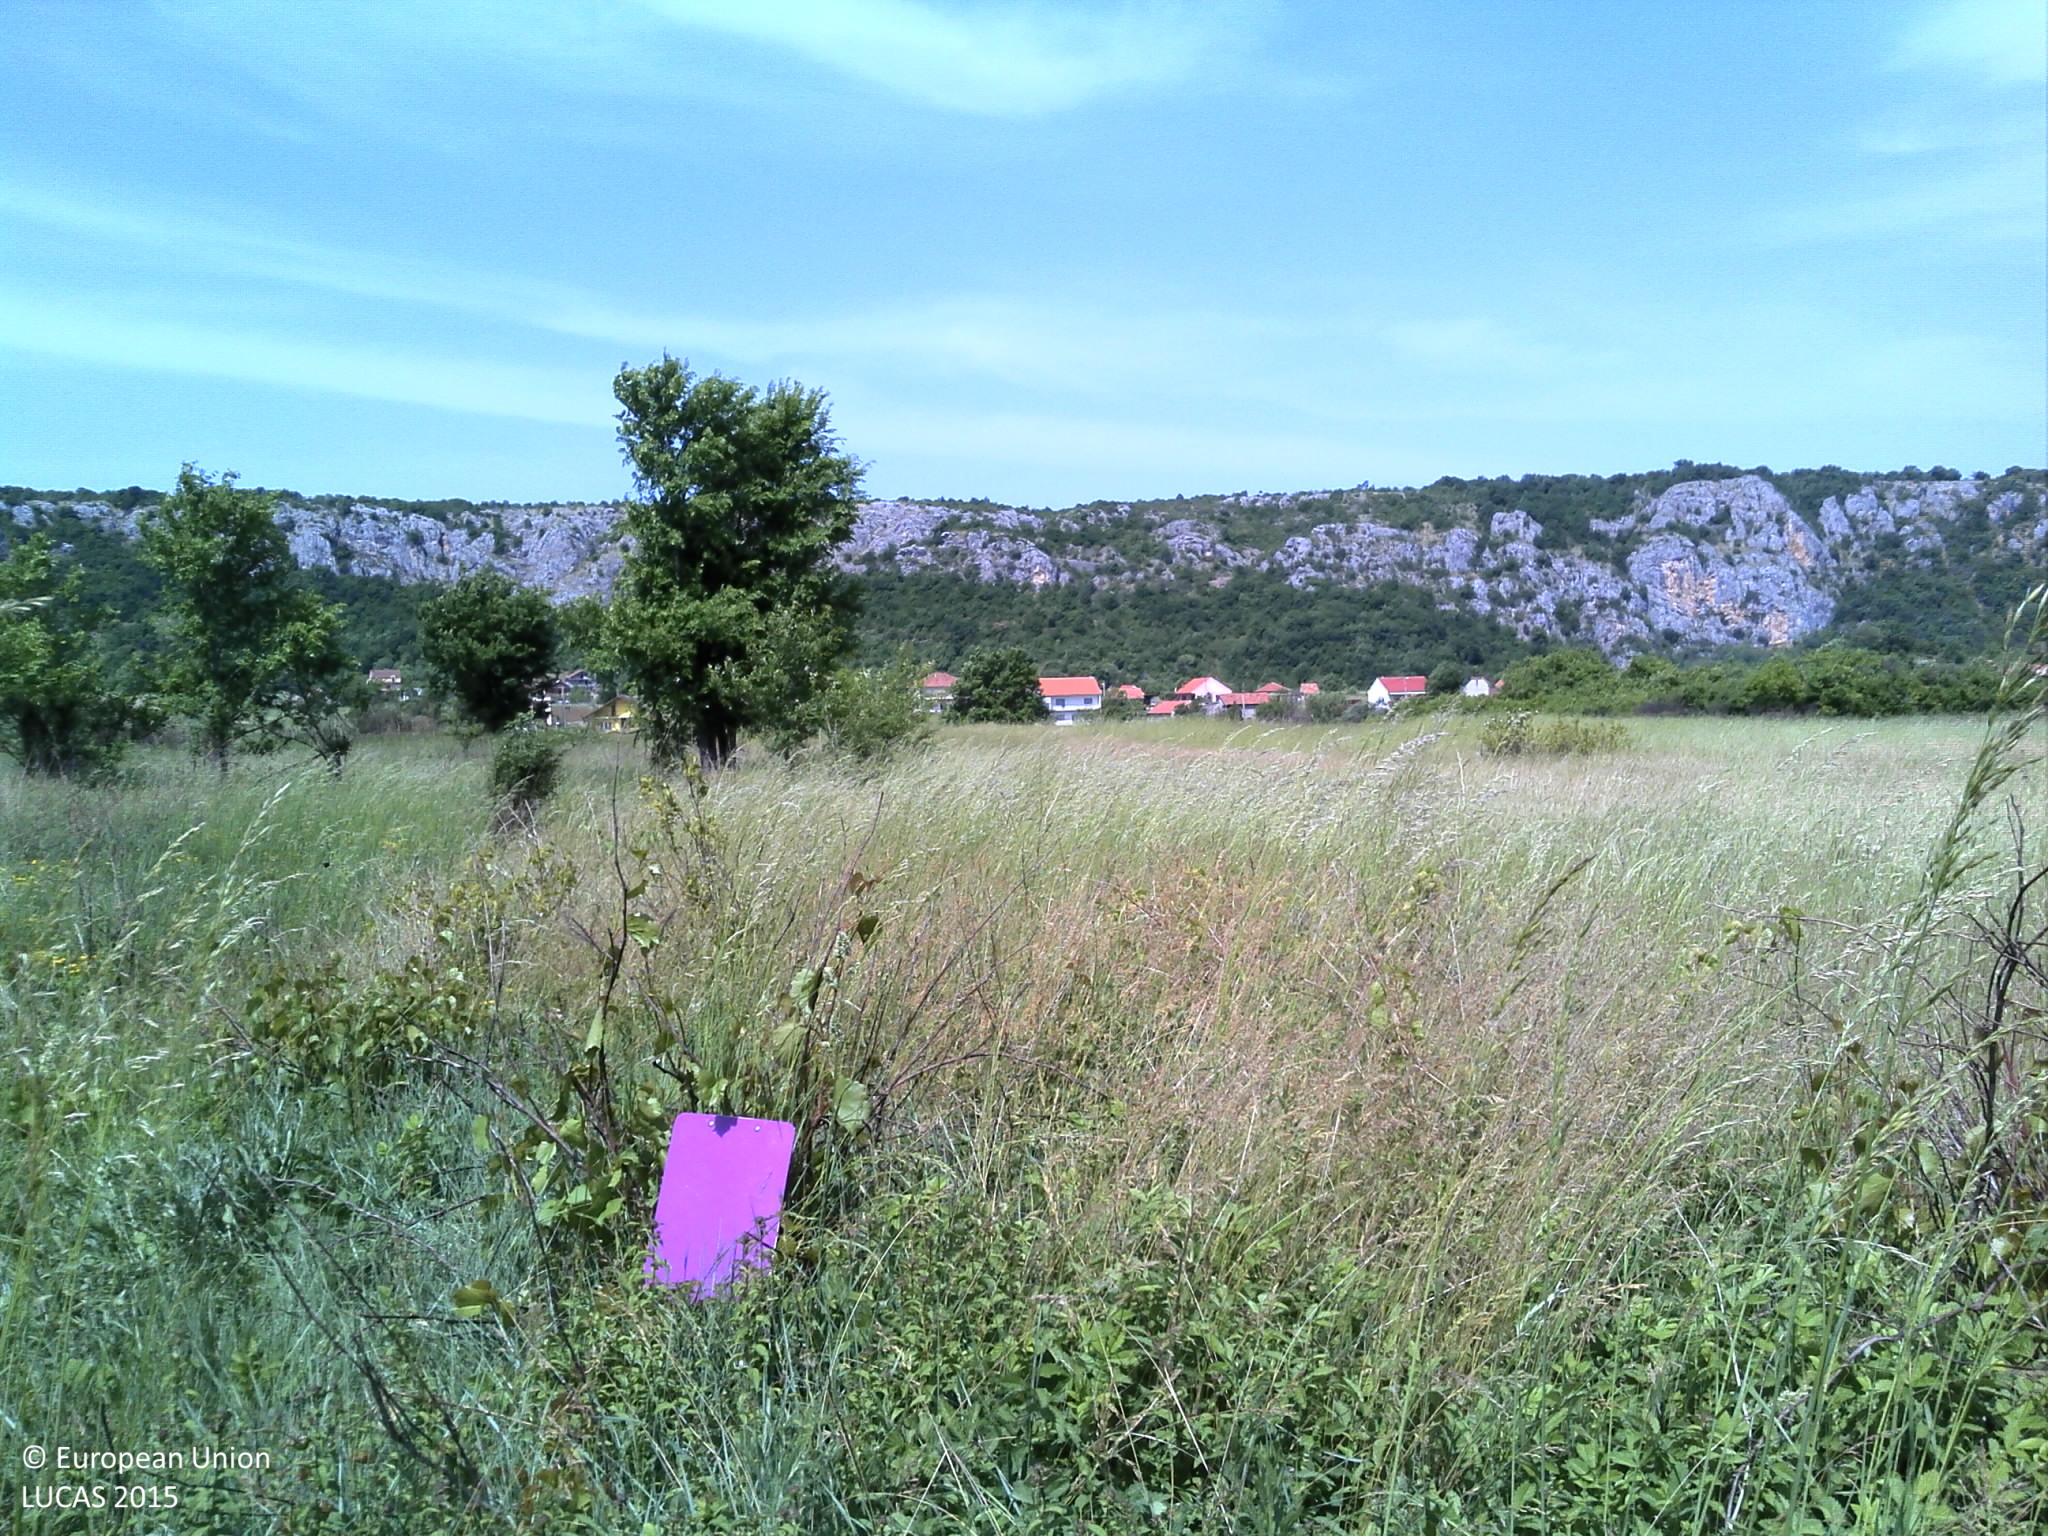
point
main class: Grassland
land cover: Grassland with sparse tree/shrub cover
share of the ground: > 75 %
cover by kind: herbaceous plants 85 %, shrubs 10 %, broadleaved forest trees 5 %
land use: Abandoned areas
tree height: < 5 m
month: May
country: HR
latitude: 43.9655
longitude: 16.2116
